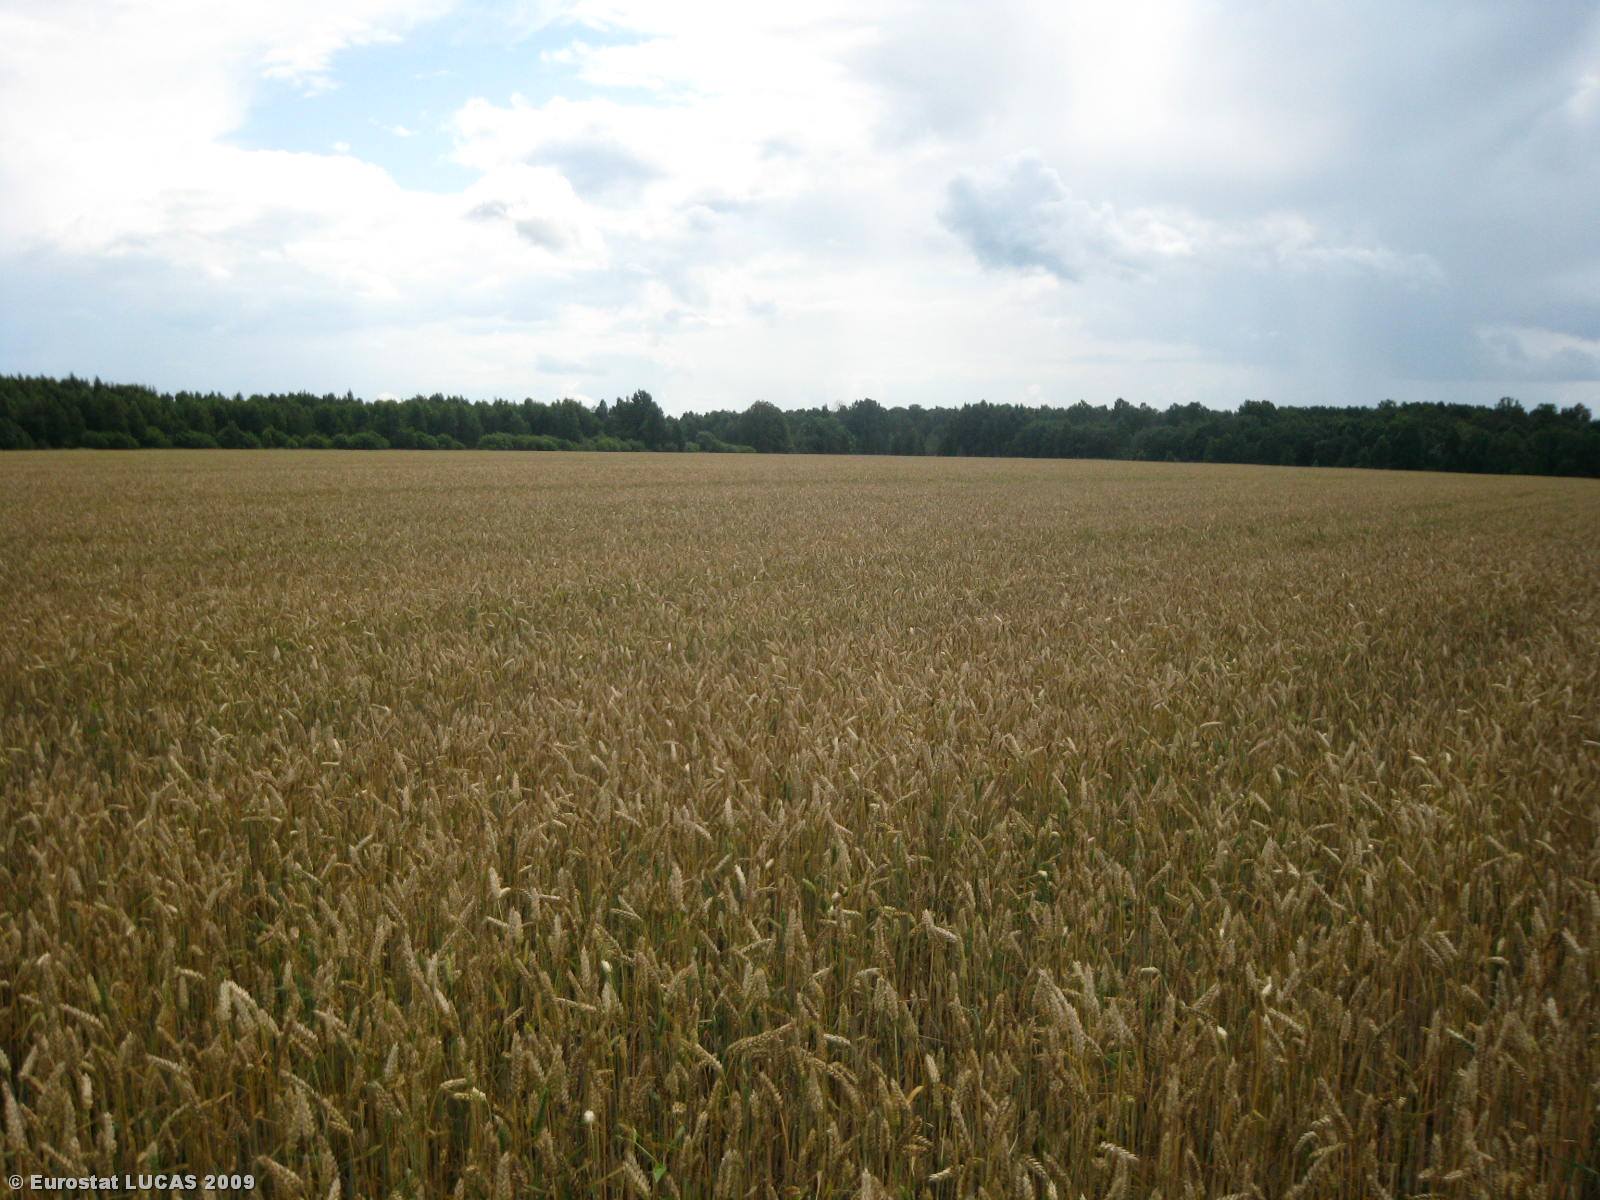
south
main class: Cropland
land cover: Common wheat
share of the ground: > 75 %
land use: Agriculture (excluding fallow land and kitchen gardens)
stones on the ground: < 10 %
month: July
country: LT
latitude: 55.6322
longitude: 24.0194
